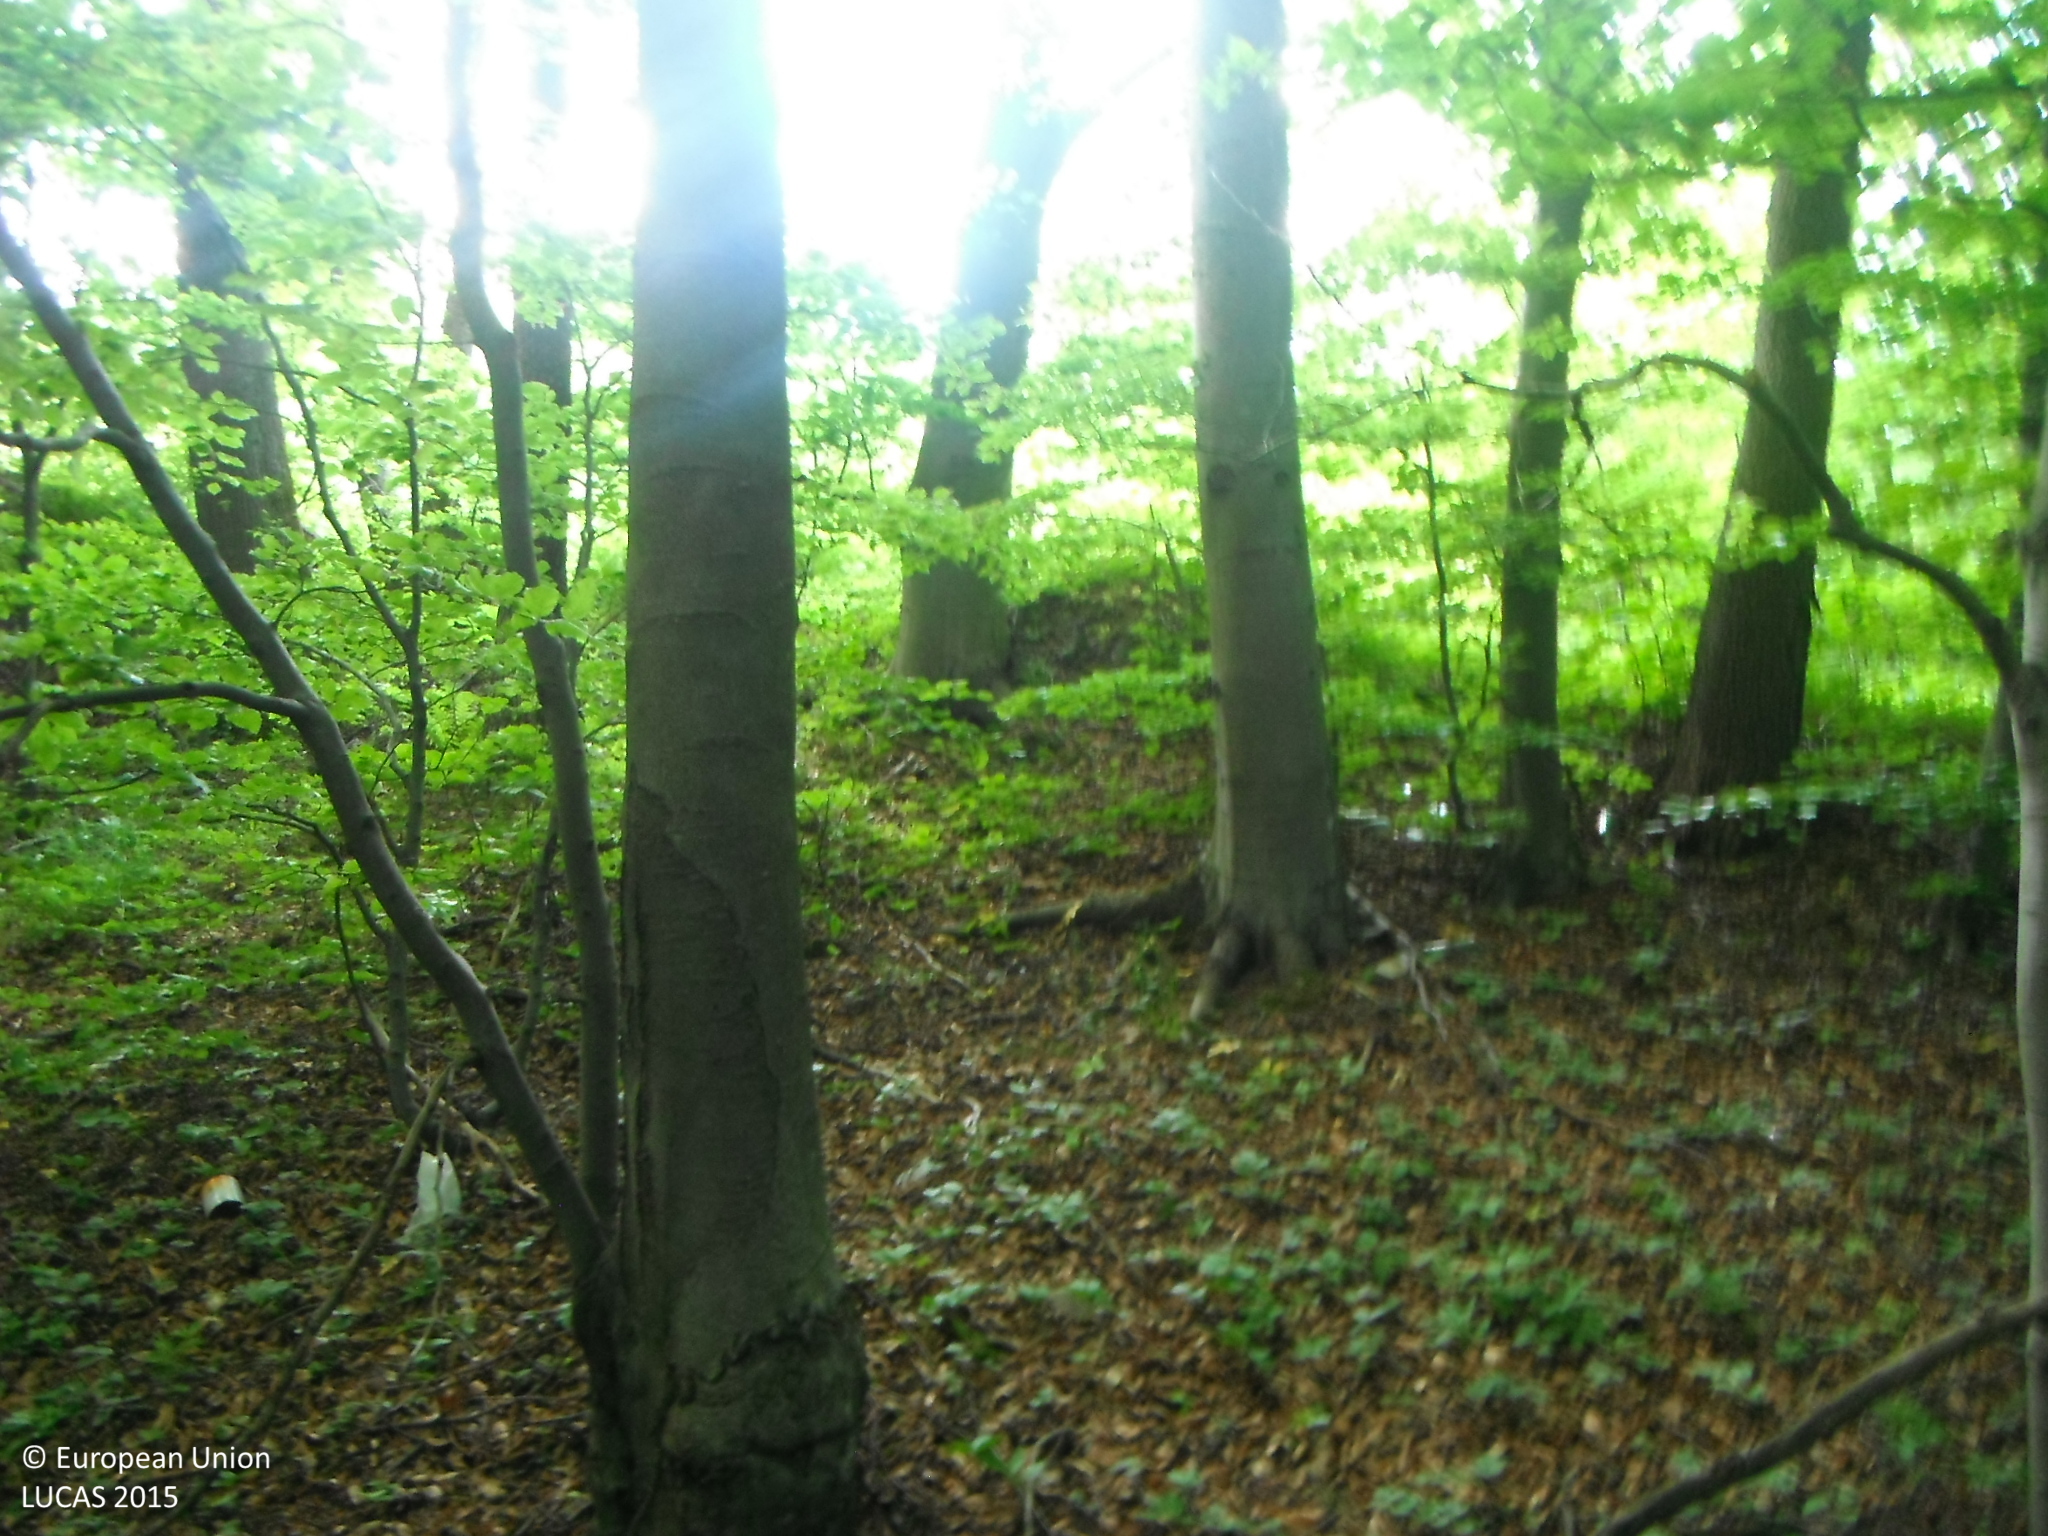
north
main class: Woodland
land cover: Broadleaved woodland
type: beech forest
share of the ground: > 75 %
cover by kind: broadleaved forest trees 100 %
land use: Forestry
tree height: > 5 m
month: May
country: SK
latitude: 48.7233
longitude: 21.0114
